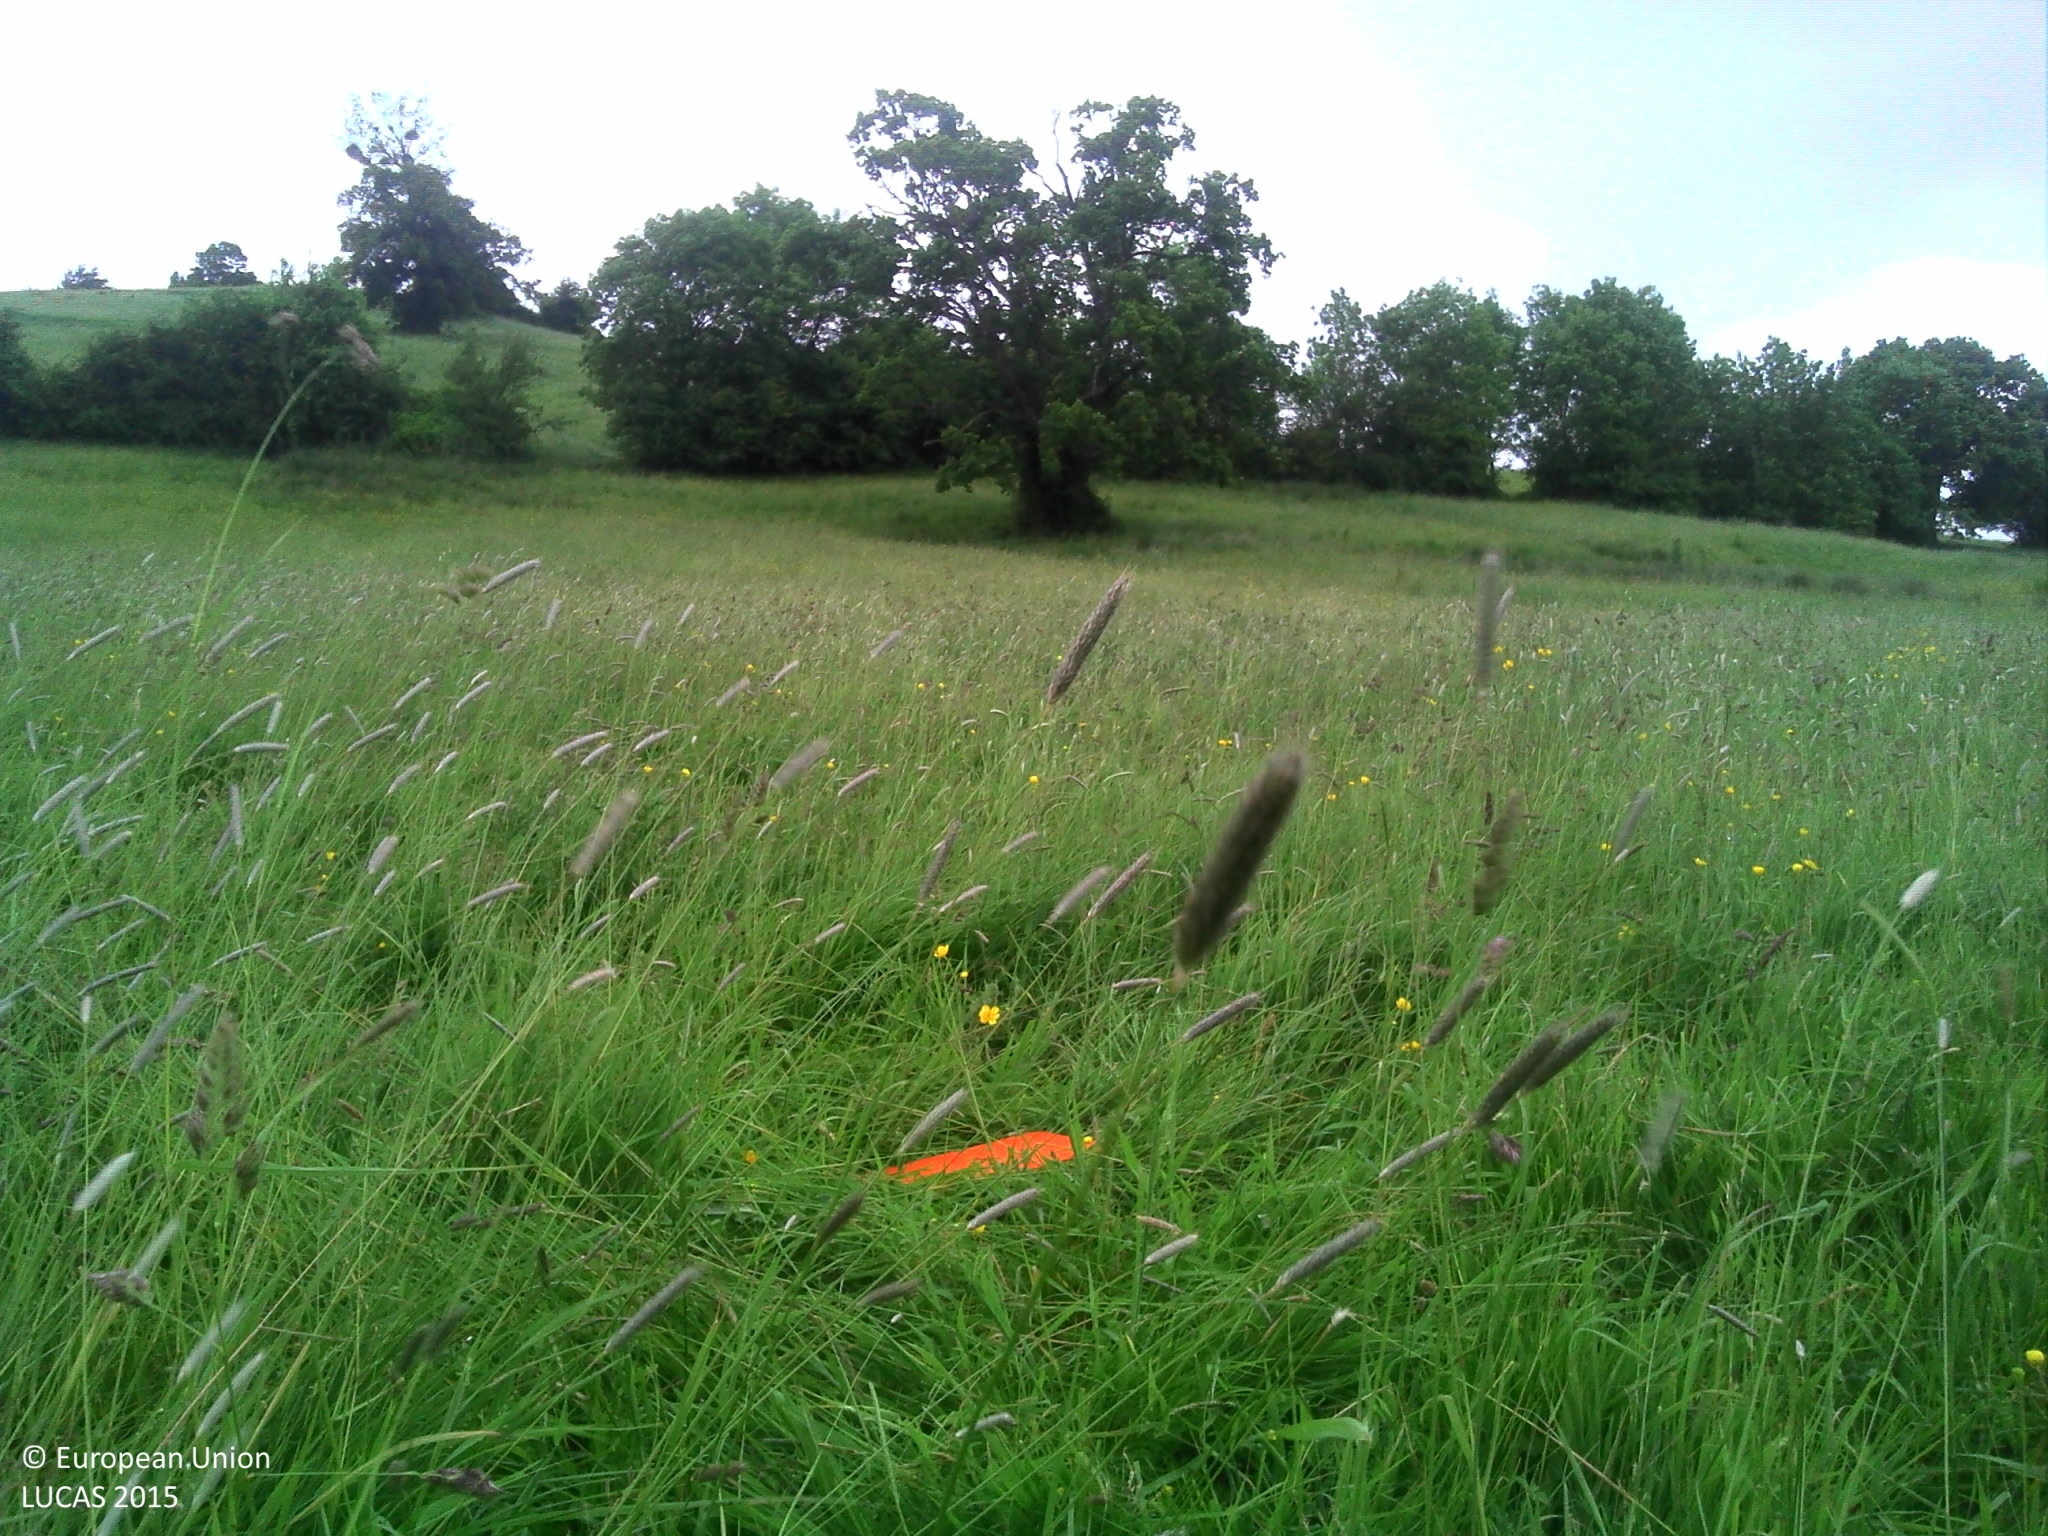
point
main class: Grassland
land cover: Grassland without tree/shrub cover
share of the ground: > 75 %
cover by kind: herbaceous plants 95 %, shrubs 5 %
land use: Agriculture (excluding fallow land and kitchen gardens)
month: June
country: FR
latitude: 48.8657
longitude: 0.1146
